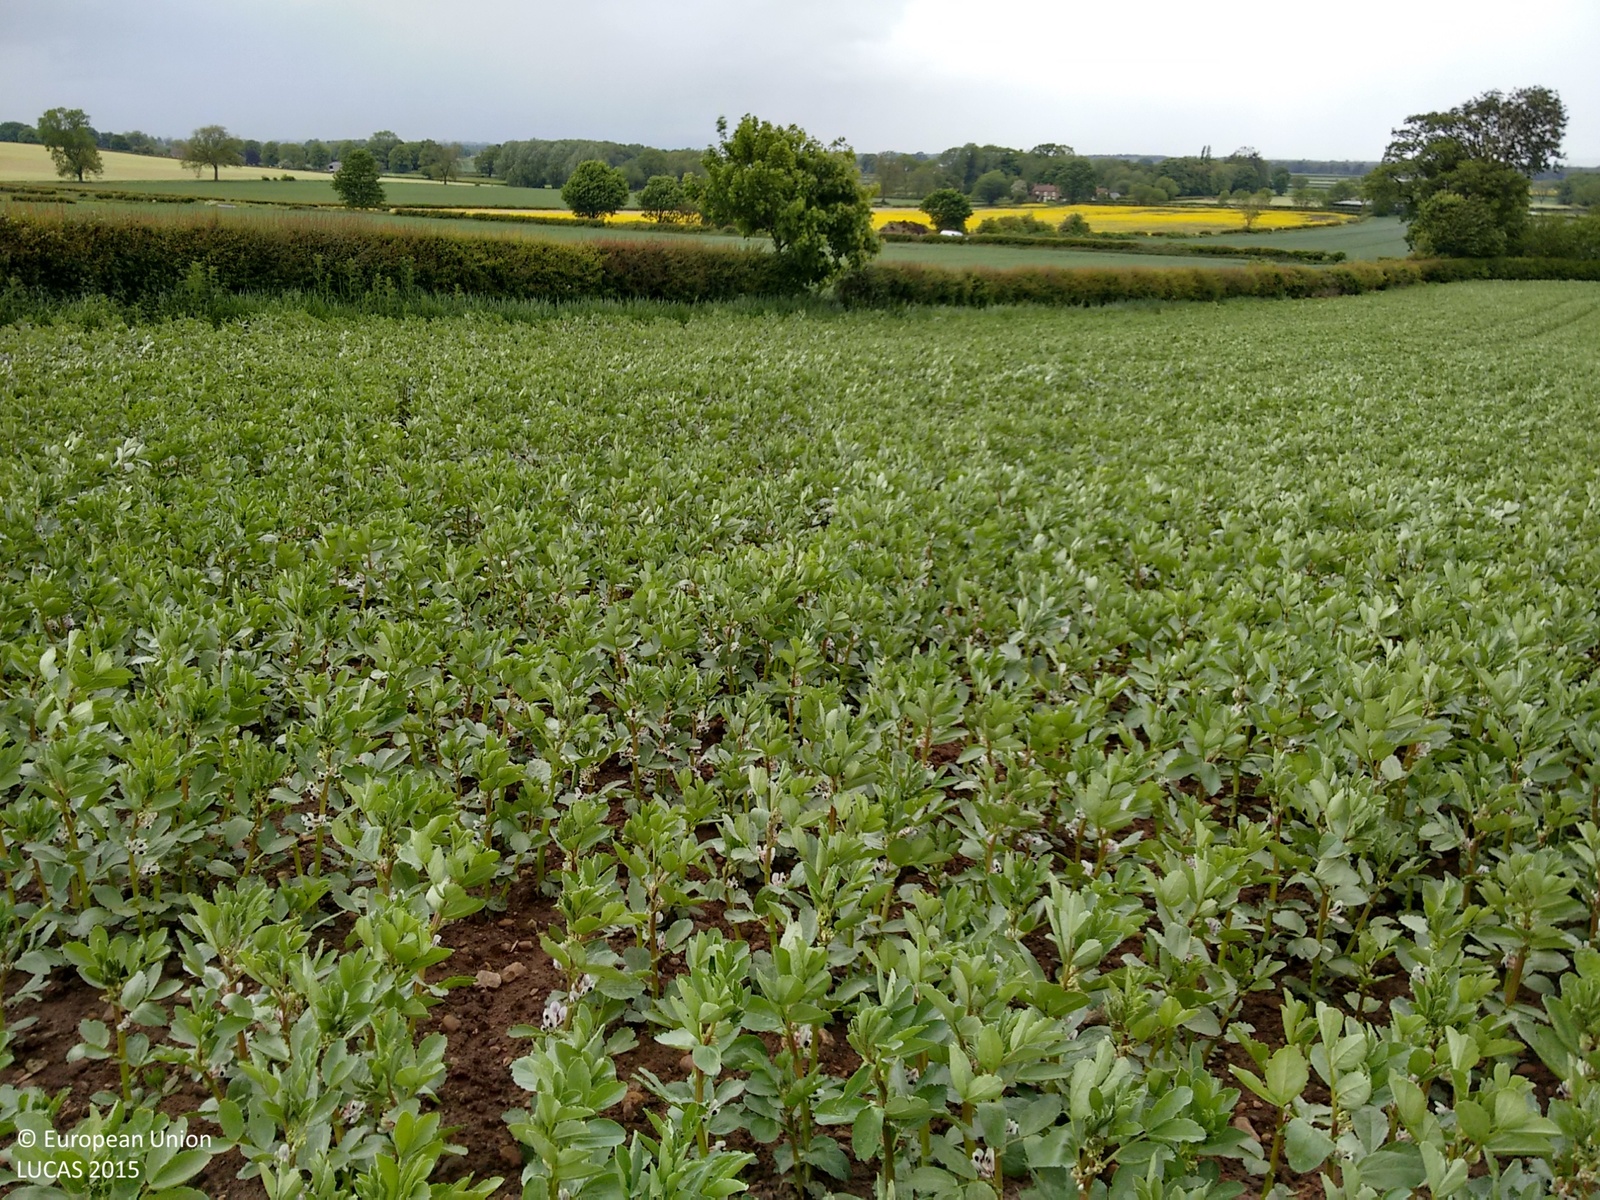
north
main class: Cropland
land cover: Dry pulses
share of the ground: > 75 %
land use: Agriculture (excluding fallow land and kitchen gardens)
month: June
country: GB
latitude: 54.0811
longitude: -1.3740
